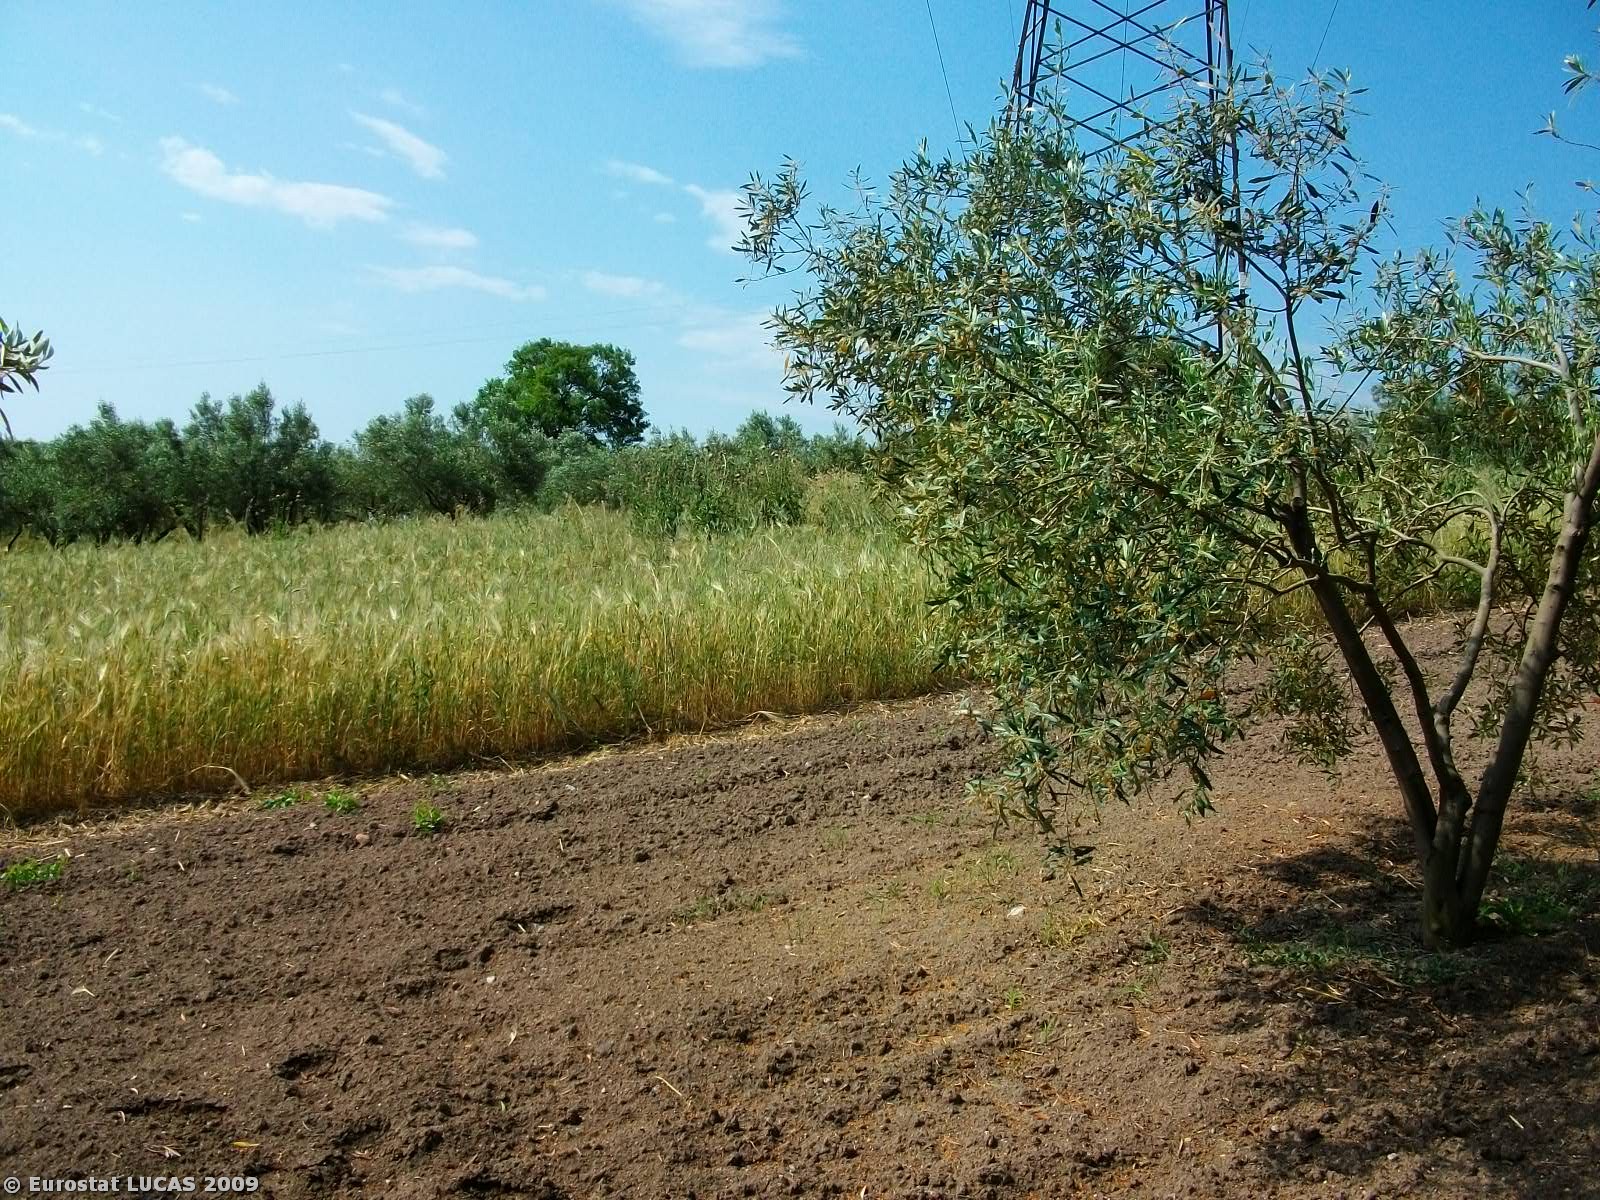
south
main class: Cropland
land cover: Olive groves
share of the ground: 50 - 75 %
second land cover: Bare land
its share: > 75 %
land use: Agriculture (excluding fallow land and kitchen gardens)
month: May
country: GR
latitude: 40.3671
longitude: 22.5893
